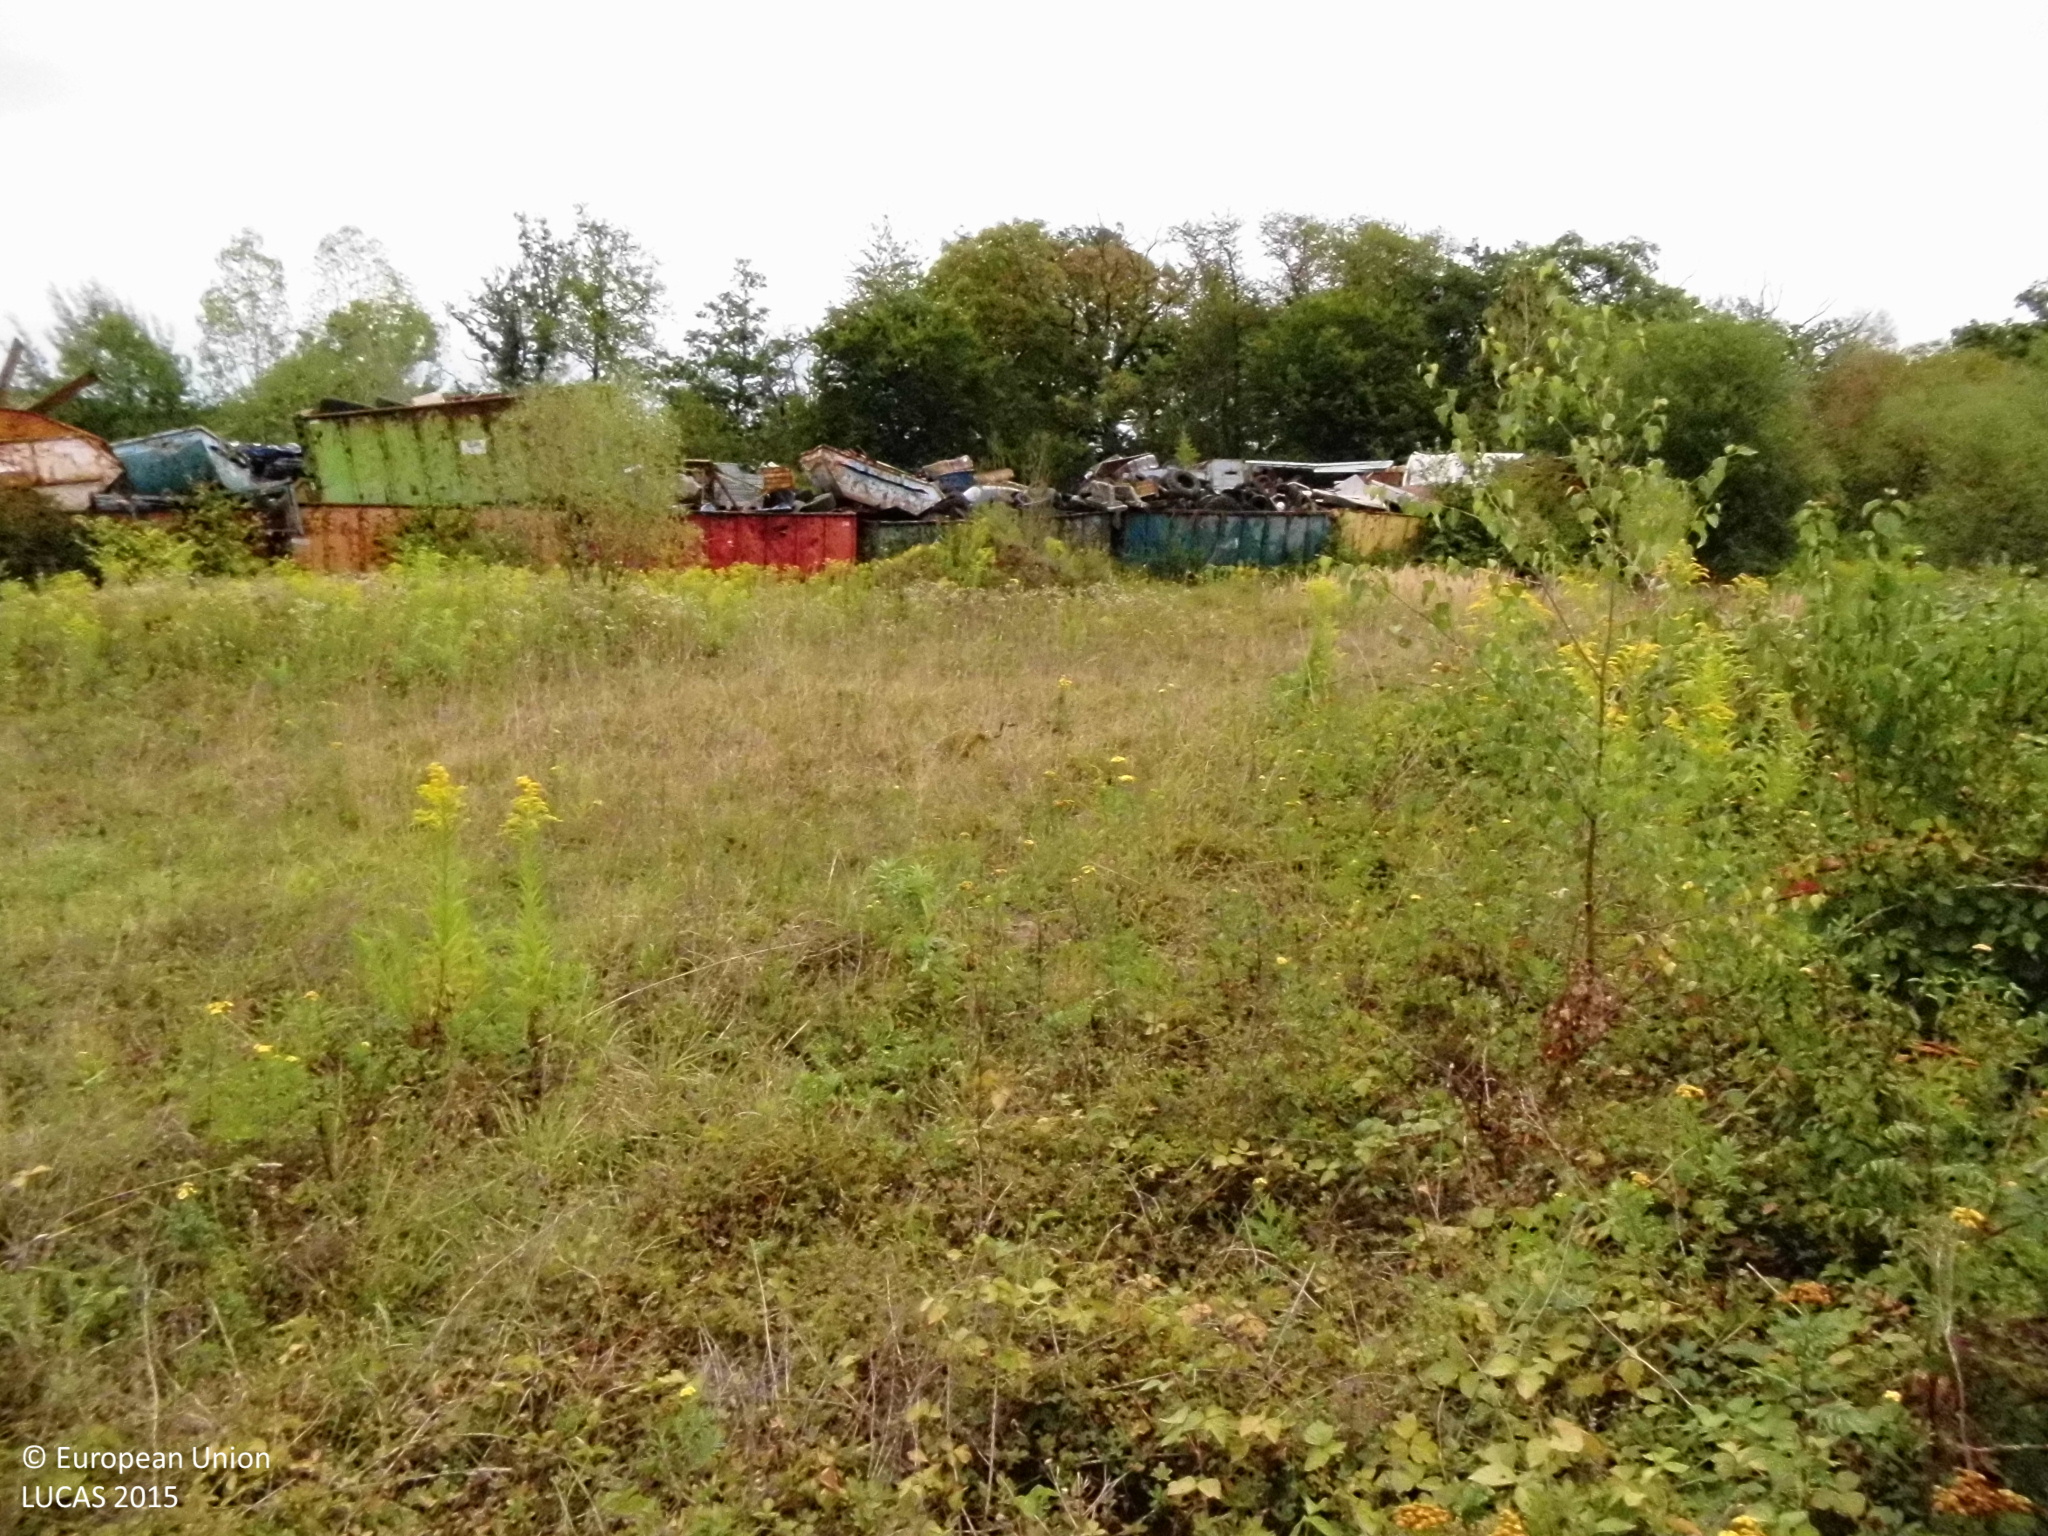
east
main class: Shrubland
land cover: Shrubland without tree cover
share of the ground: > 75 %
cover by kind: shrubs 90 %, herbaceous plants 10 %
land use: Semi-natural and natural areas not in use
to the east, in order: Shrubland without tree cover; Spontaneously vegetated surfaces; Shrubland without tree cover; Artificial constructions in urban areas; Broadleaved woodland; Artificial constructions in urban areas
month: August
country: DE
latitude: 50.4027
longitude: 8.1292
